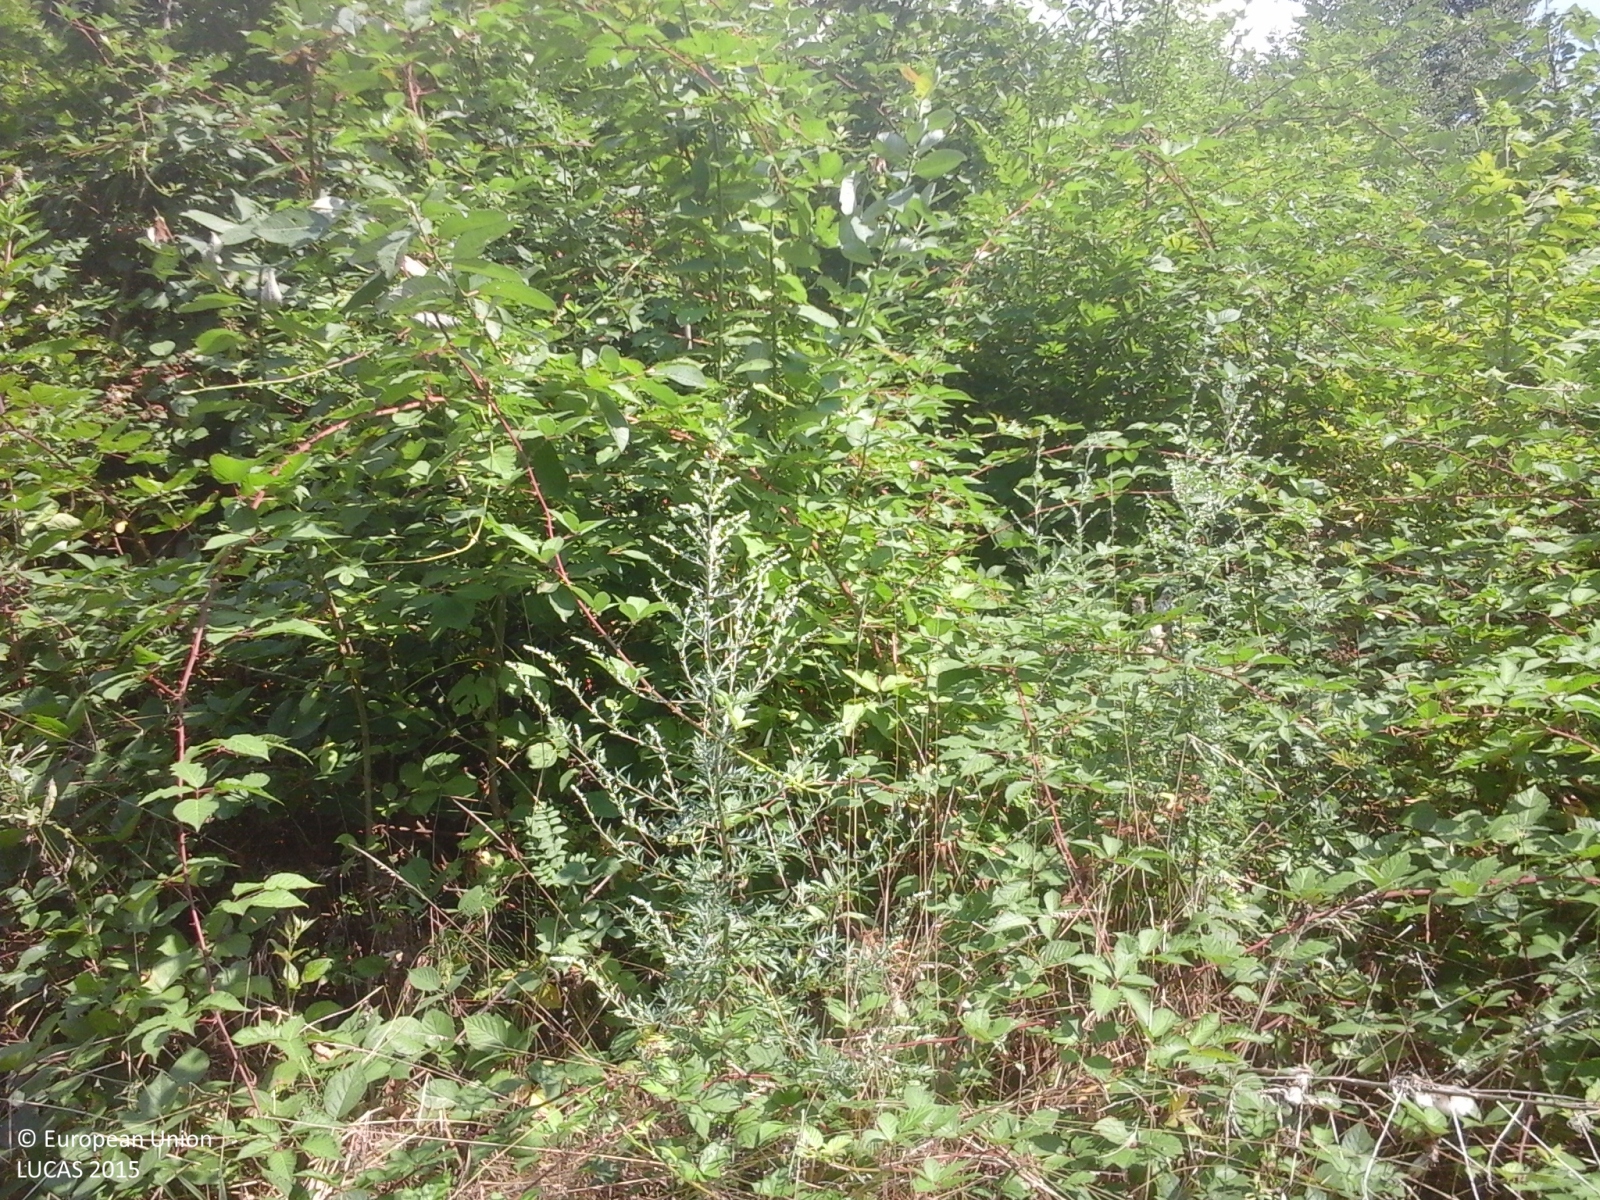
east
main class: Woodland
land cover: Broadleaved woodland
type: thermophilous deciduous forest
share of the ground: > 75 %
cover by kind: broadleaved forest trees 80 %, coniferous forest trees 10 %, shrubs 5 %, herbaceous plants 5 %
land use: Forestry
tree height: > 5 m
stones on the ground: > 50 %
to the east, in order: Broadleaved woodland; Grassland without tree/shrub cover; Broadleaved woodland; Ditches and canals; Broadleaved woodland; Grassland without tree/shrub cover
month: August
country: IT
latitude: 46.0251
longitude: 9.3679
